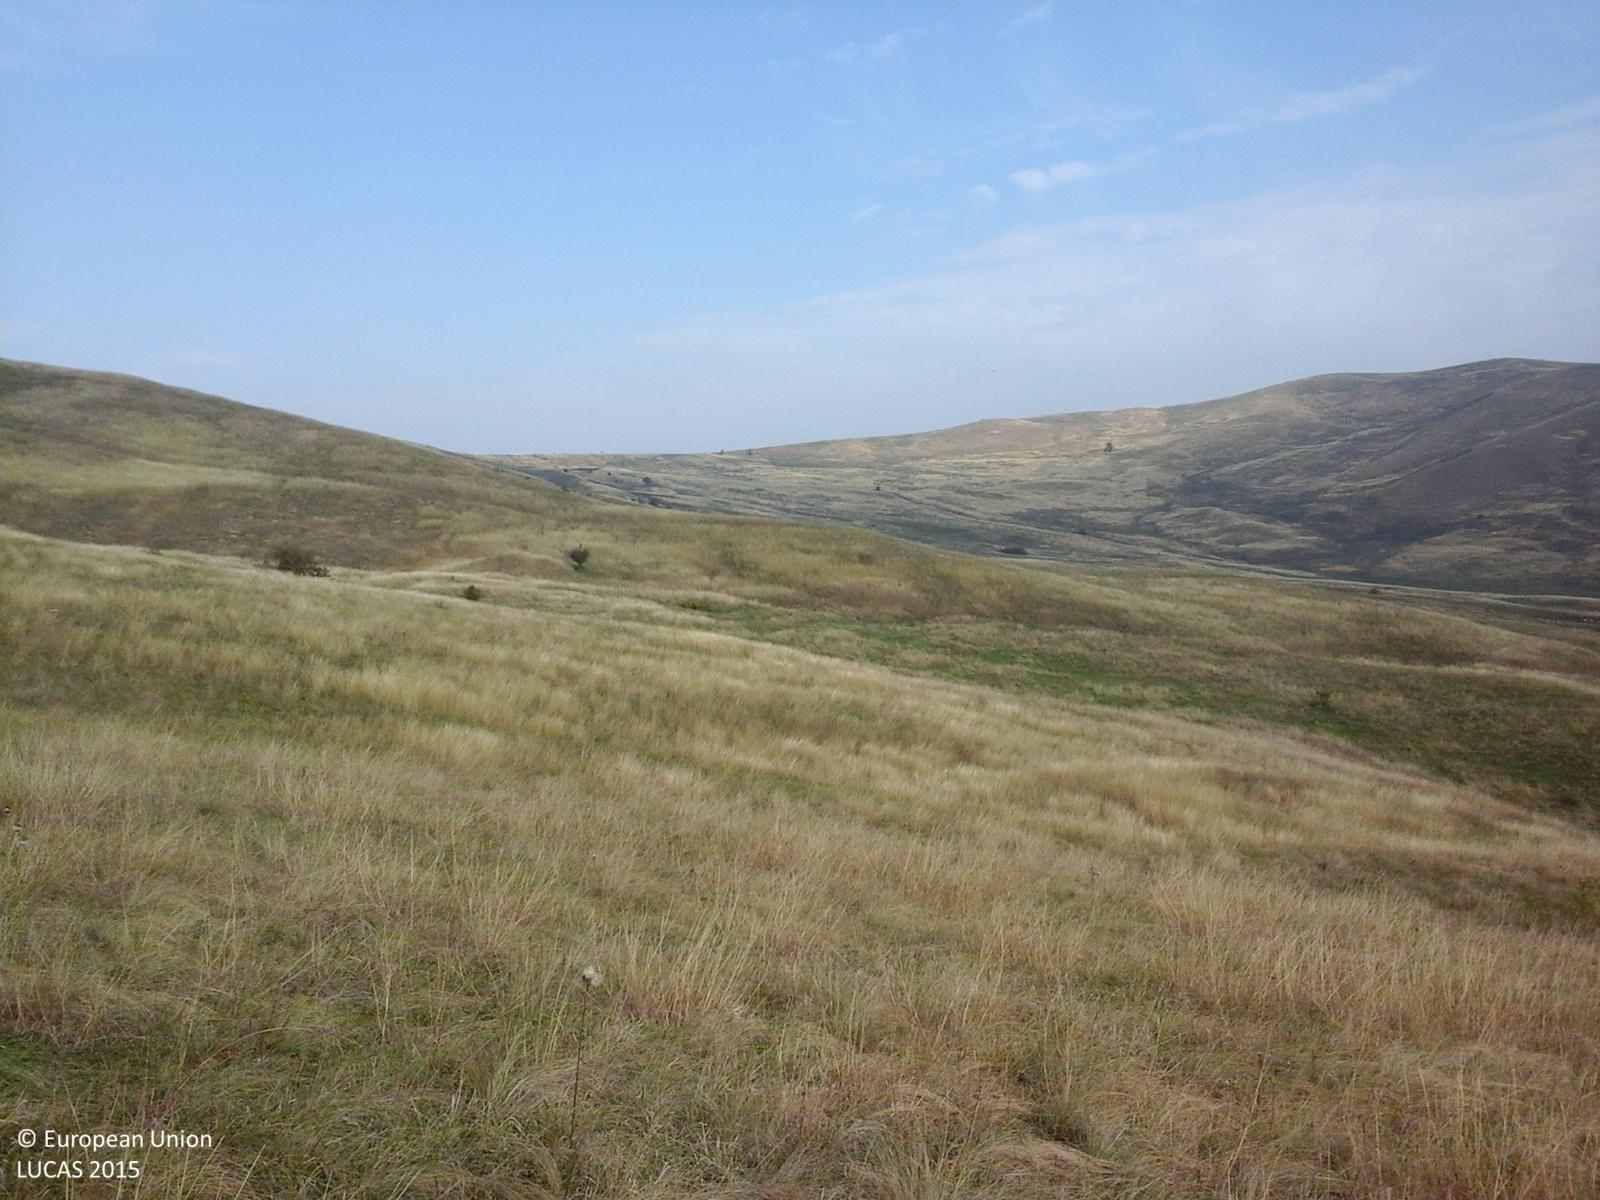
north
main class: Grassland
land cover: Grassland without tree/shrub cover
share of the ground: > 75 %
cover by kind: herbaceous plants 100 %
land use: Agriculture (excluding fallow land and kitchen gardens)
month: October
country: RO
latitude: 46.4548
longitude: 23.8085
